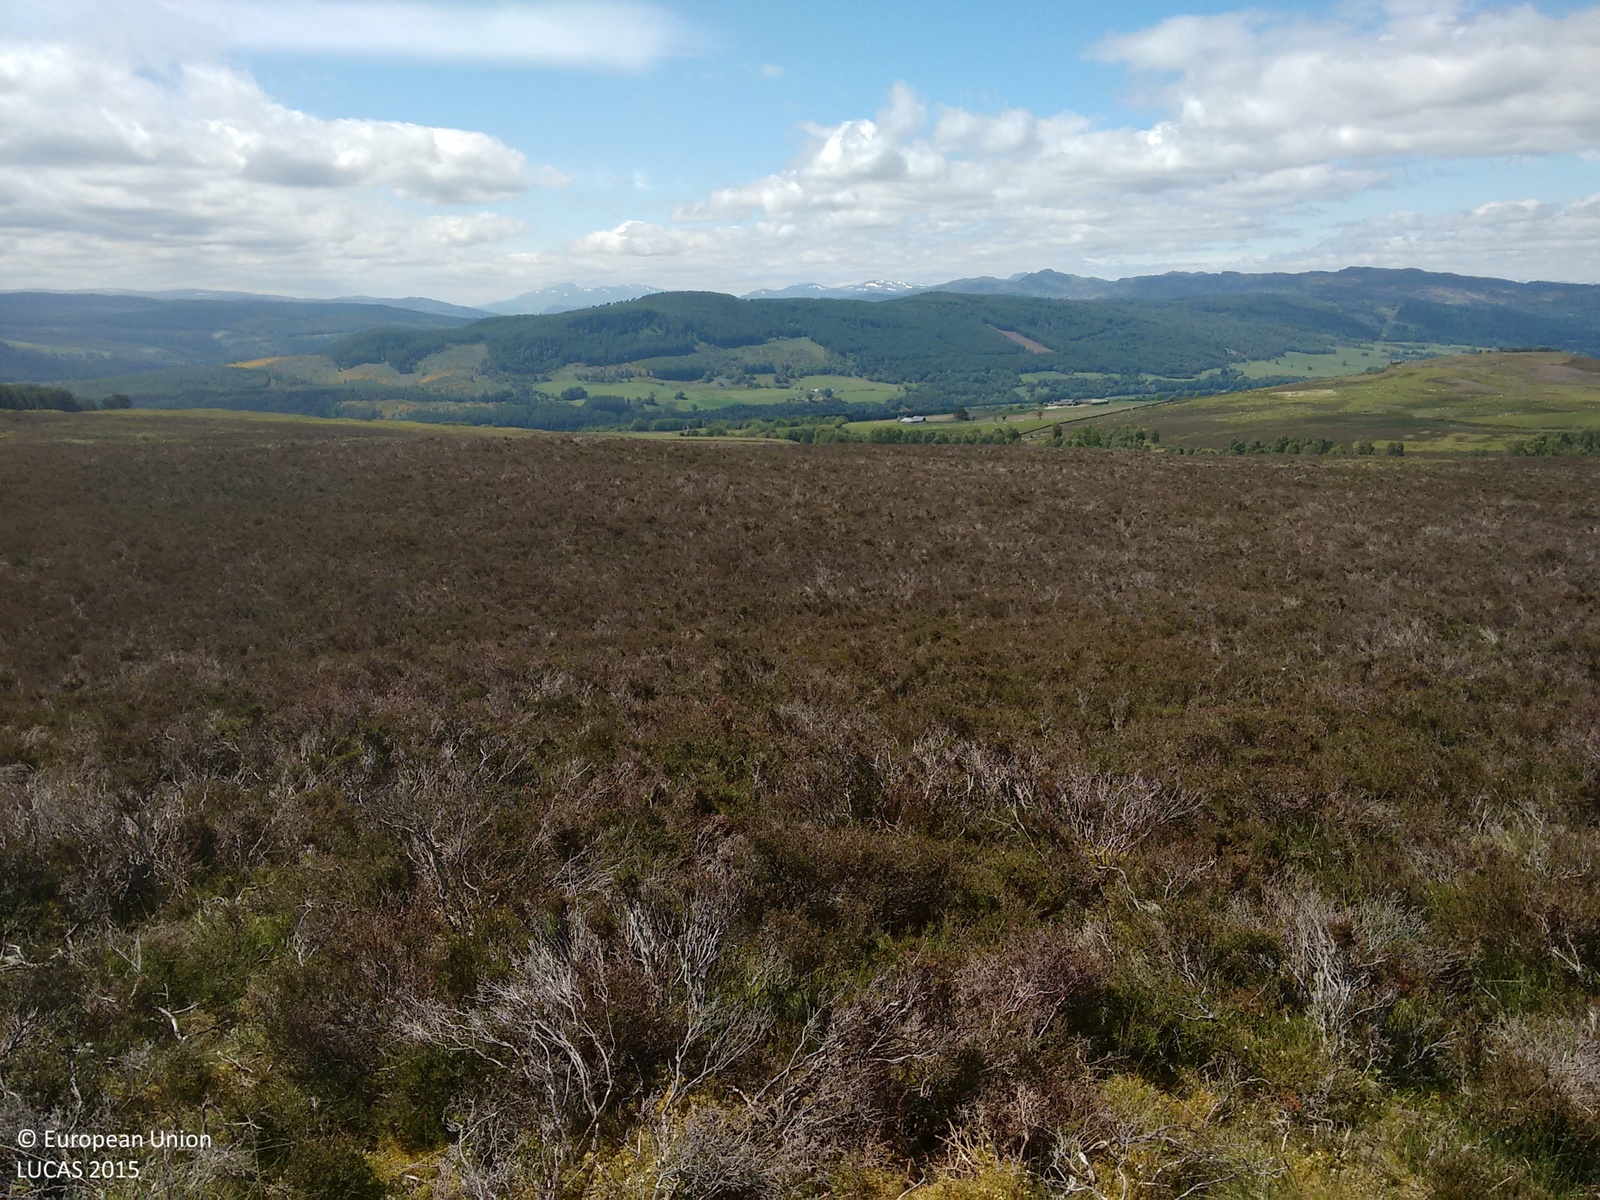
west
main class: Shrubland
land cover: Shrubland without tree cover
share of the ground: > 75 %
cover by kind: shrubs 90 %, herbaceous plants 10 %
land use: Semi-natural and natural areas not in use
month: June
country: GB
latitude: 56.6787
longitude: -3.6408
